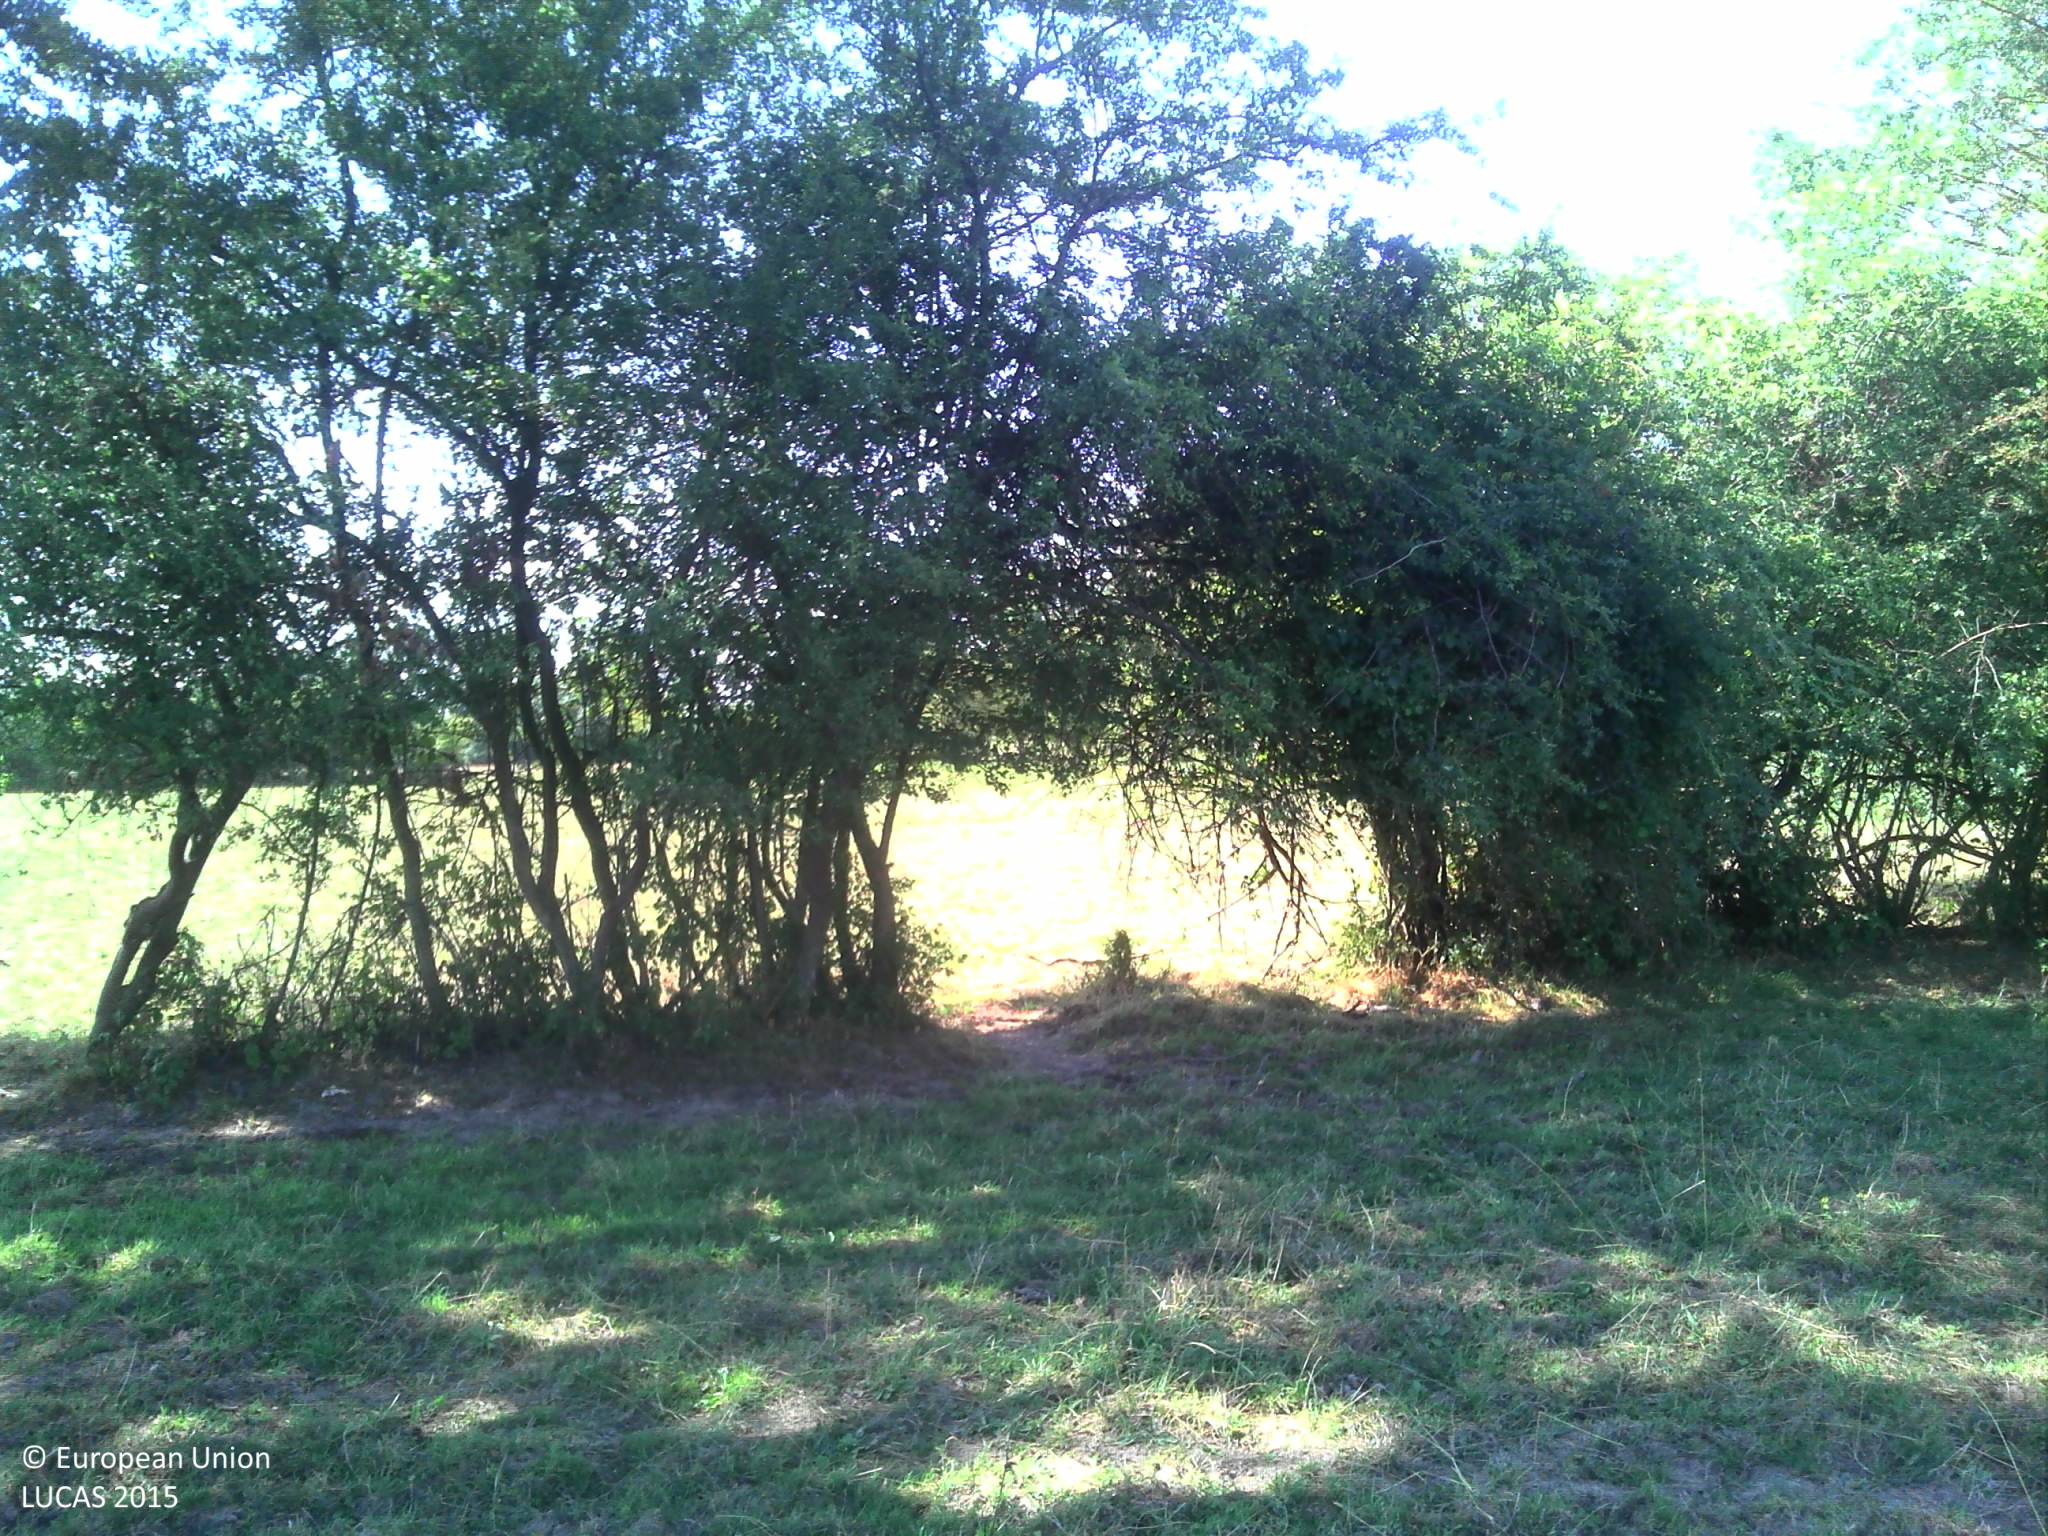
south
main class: Grassland
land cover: Grassland without tree/shrub cover
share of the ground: > 75 %
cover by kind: herbaceous plants 100 %
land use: Agriculture (excluding fallow land and kitchen gardens)
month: July
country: FR
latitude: 46.7378
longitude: 4.9629
